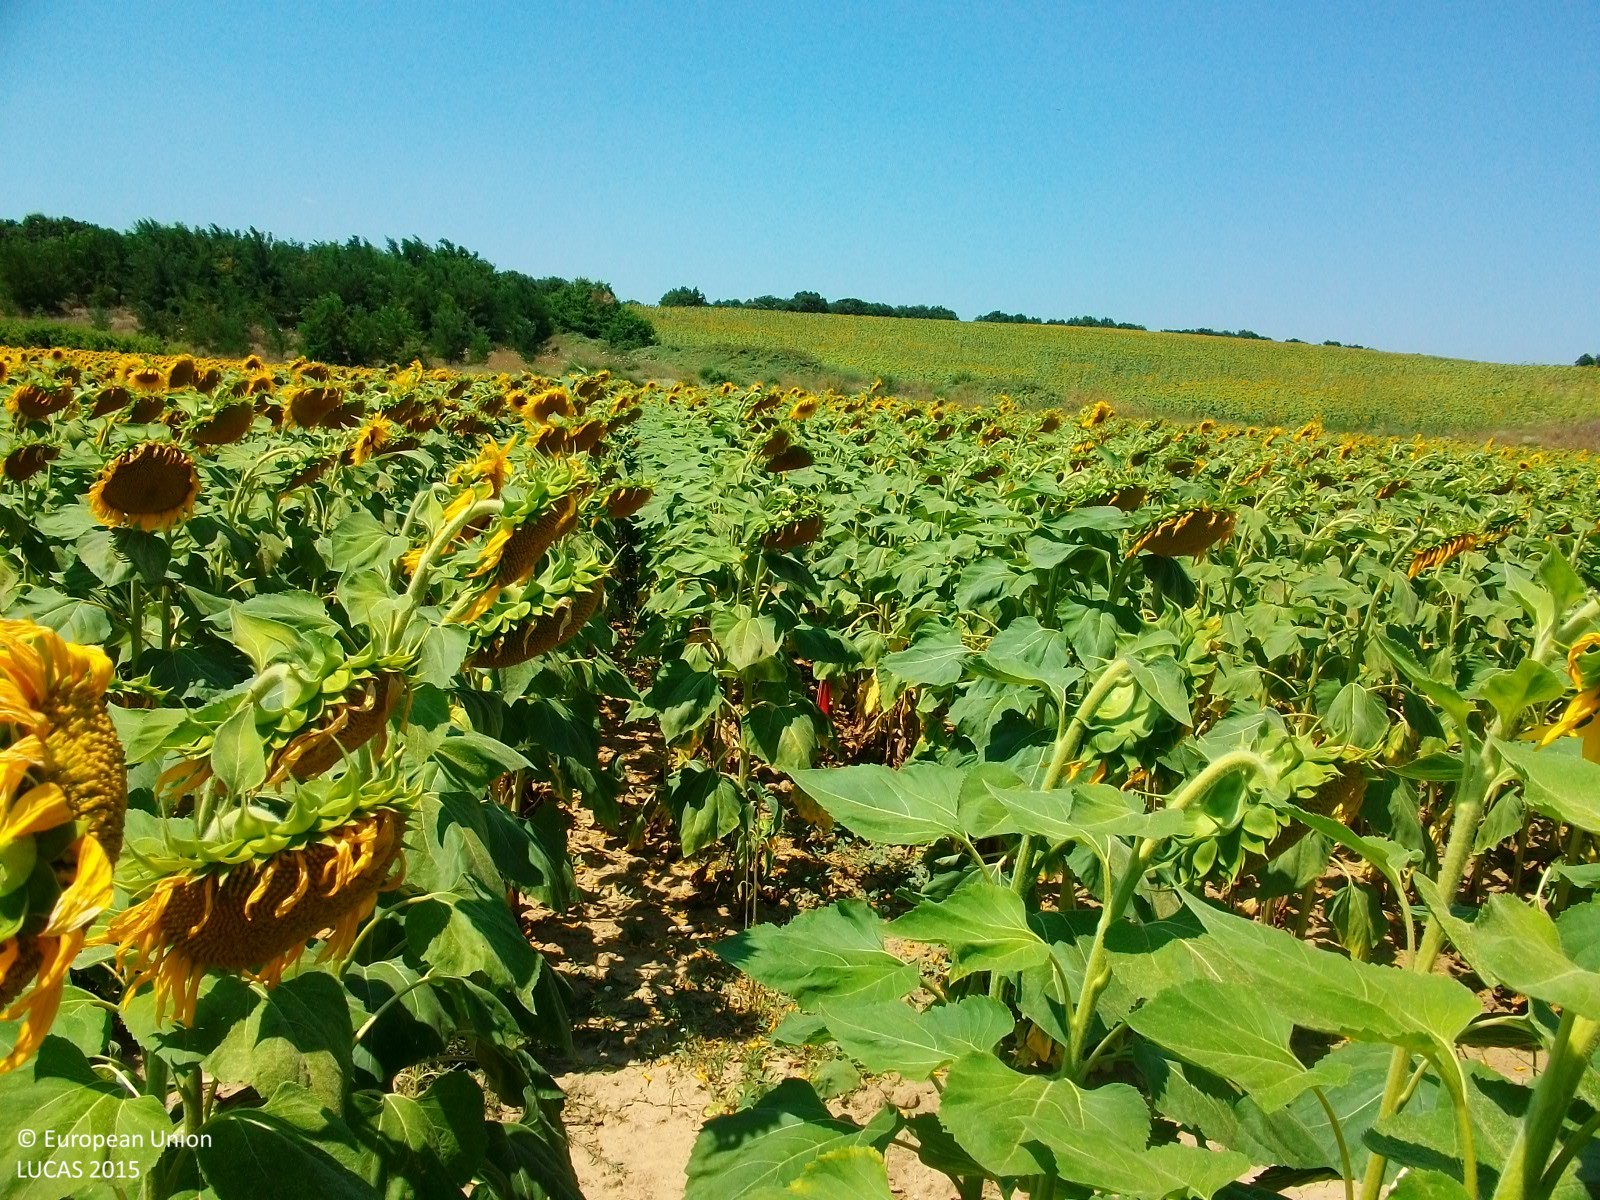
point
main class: Cropland
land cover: Sunflower
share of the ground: > 75 %
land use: Agriculture (excluding fallow land and kitchen gardens)
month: July
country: GR
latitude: 40.9383
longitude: 26.1813
